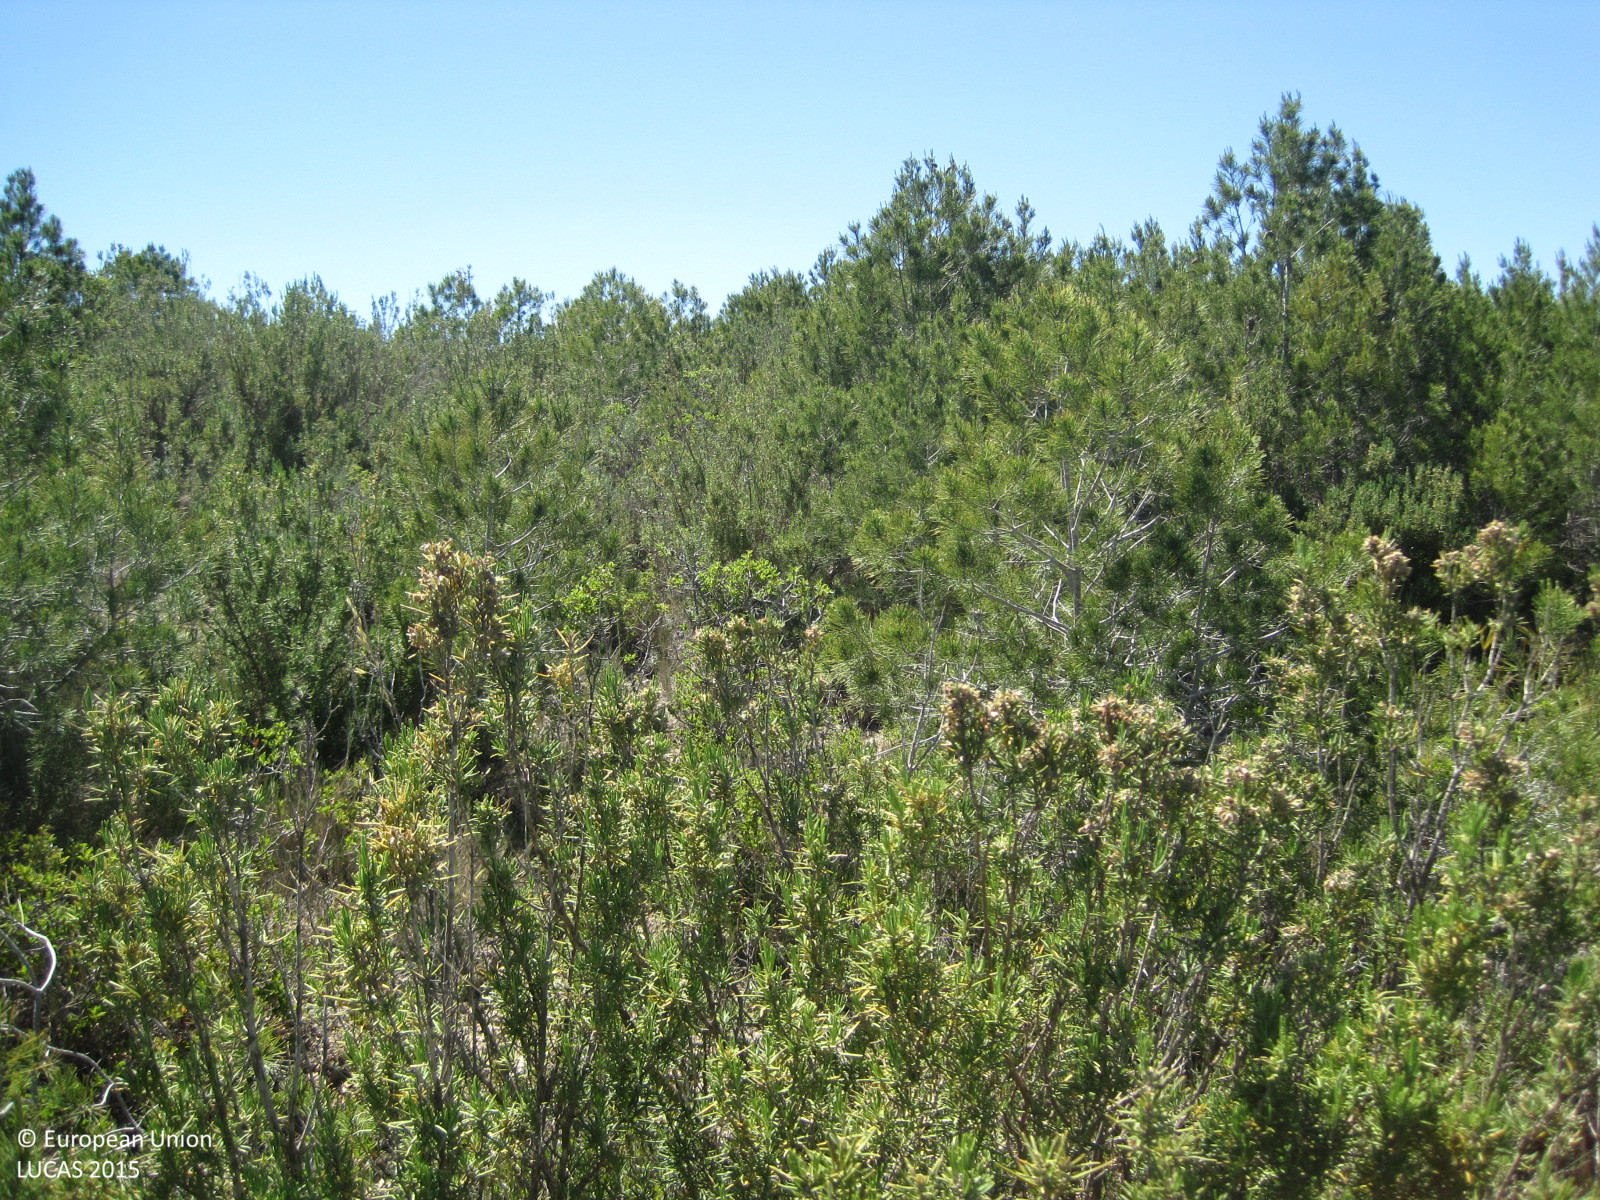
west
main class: Woodland
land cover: Pine dominated coniferous woodland
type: coniferous forest of the mediterranean region
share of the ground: > 75 %
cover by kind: coniferous forest trees 90 %, shrubs 10 %
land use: Forestry
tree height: < 5 m
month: May
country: ES
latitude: 39.3814
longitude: -1.0868
